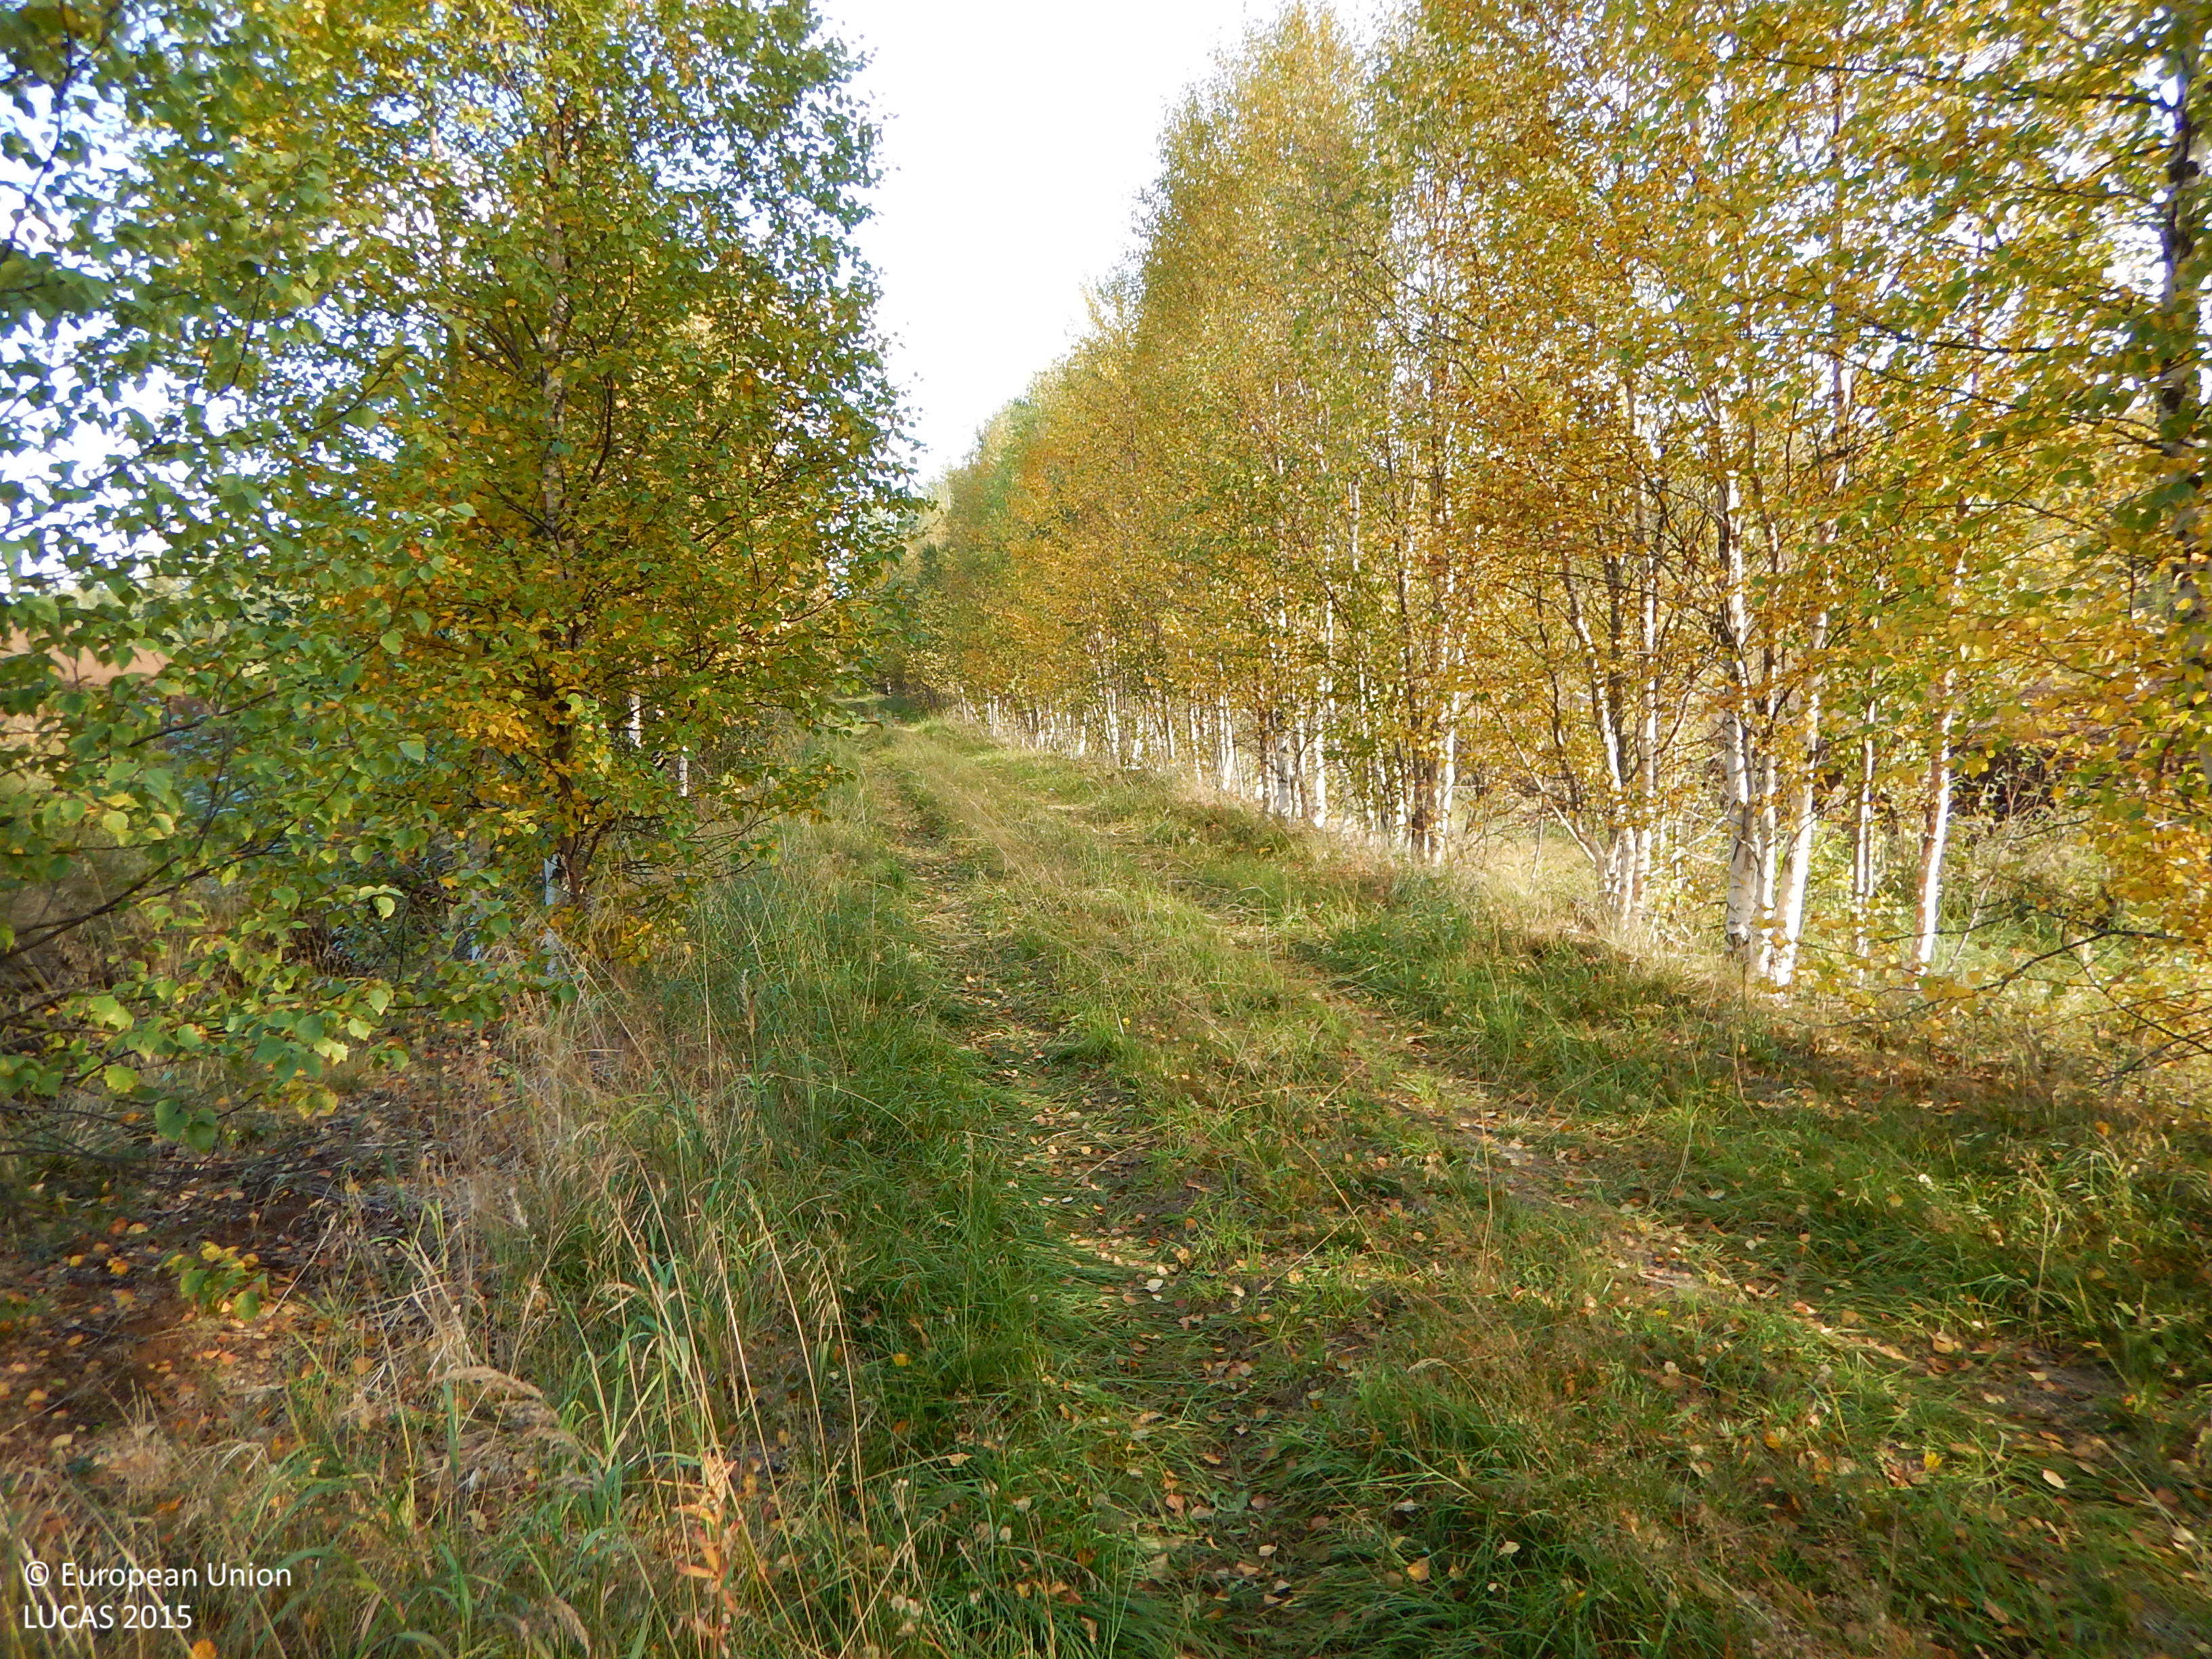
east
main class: Woodland
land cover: Pine dominated mixed woodland
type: boreal forest
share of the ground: 50 - 75 %
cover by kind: coniferous forest trees 40 %, broadleaved forest trees 20 %, shrubs 15 %, lichens and mosses 15 %, herbaceous plants 10 %
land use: Forestry
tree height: > 5 m
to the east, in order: Groves; Grass margins; Tracks; Groves; Ditches and canals; Pine dominated mixed woodland; Pine dominated coniferous woodland; Tracks; Spruce dominated coniferous woodland; Tracks; Pine dominated mixed woodland
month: September
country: SE
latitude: 64.7055
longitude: 20.2308
